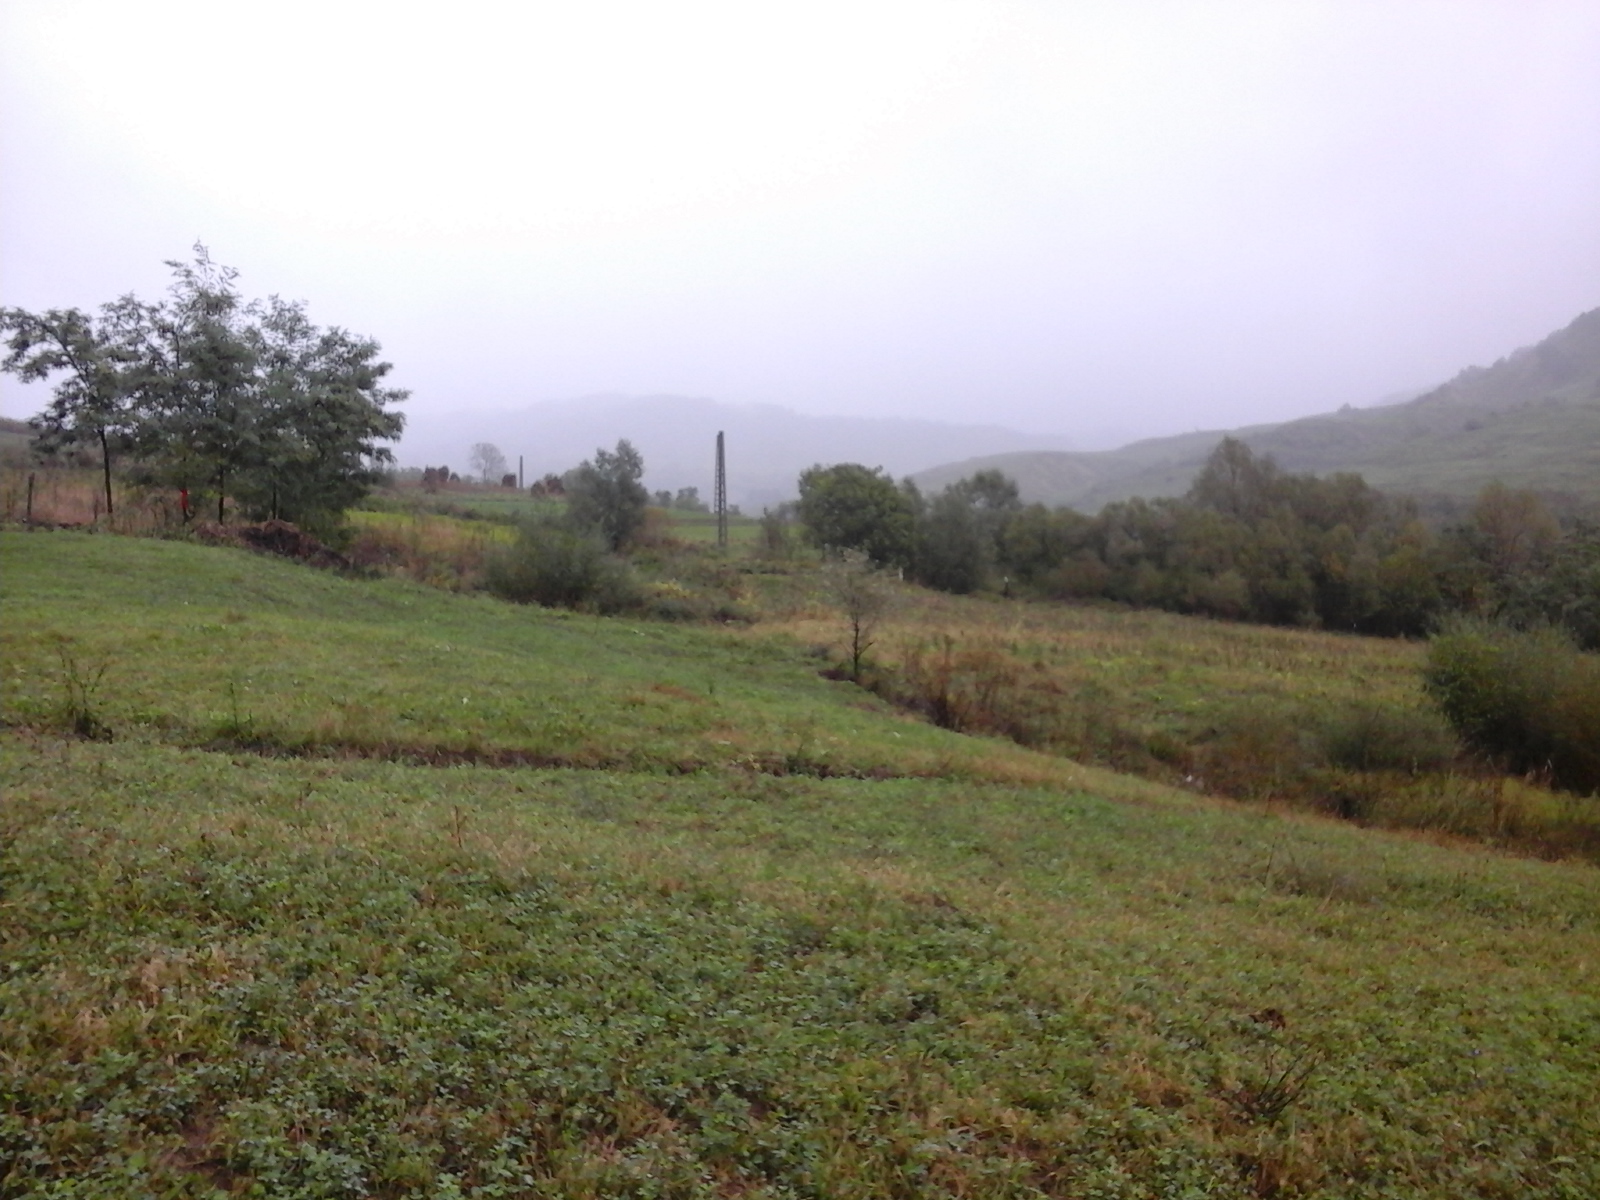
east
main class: Cropland
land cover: Other leguminous and mixtures for fodder
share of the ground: > 75 %
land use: Agriculture (excluding fallow land and kitchen gardens)
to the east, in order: Other leguminous and mixtures for fodder; Grassland without tree/shrub cover; Grass margins; Tracks; Spontaneously vegetated surfaces; Maize; Grassland without tree/shrub cover; Maize; Grassland without tree/shrub cover
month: September
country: RO
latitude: 45.0324
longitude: 23.6544
